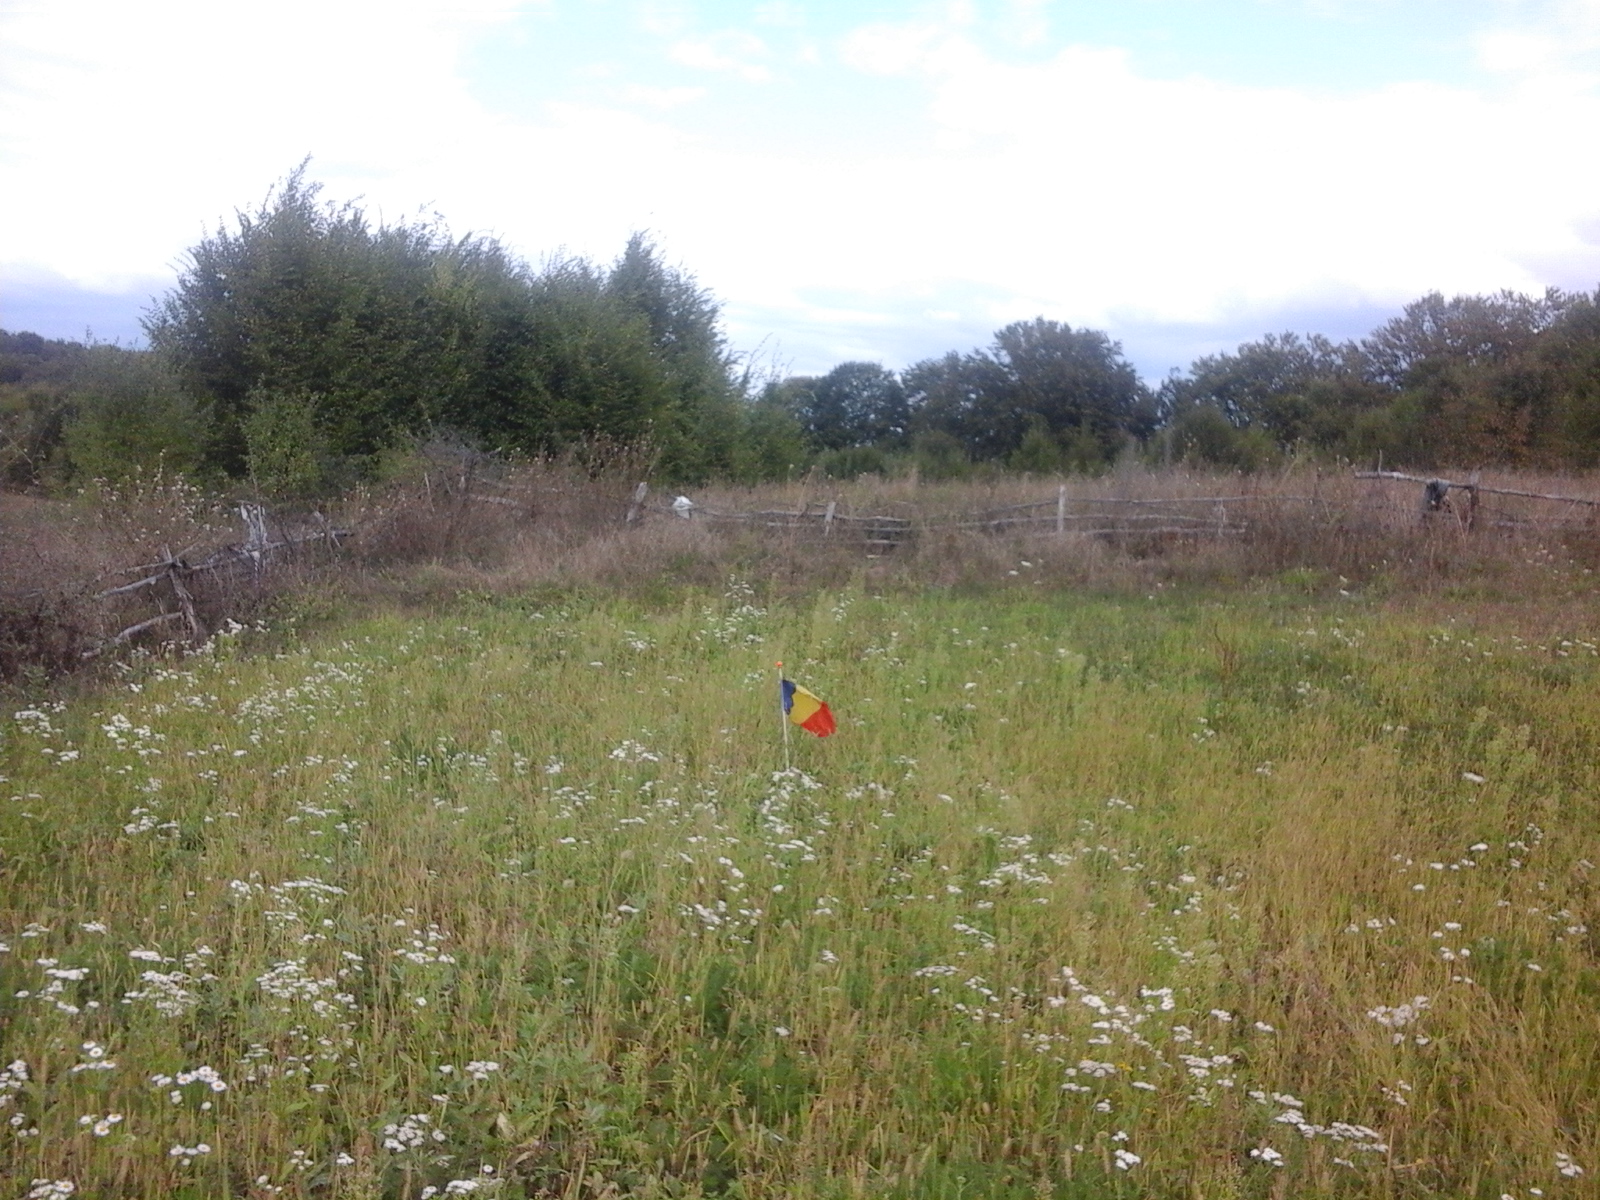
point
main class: Grassland
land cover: Grassland without tree/shrub cover
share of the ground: > 75 %
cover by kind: herbaceous plants 100 %
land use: Agriculture (excluding fallow land and kitchen gardens)
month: September
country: RO
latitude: 47.4303
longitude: 23.7466
